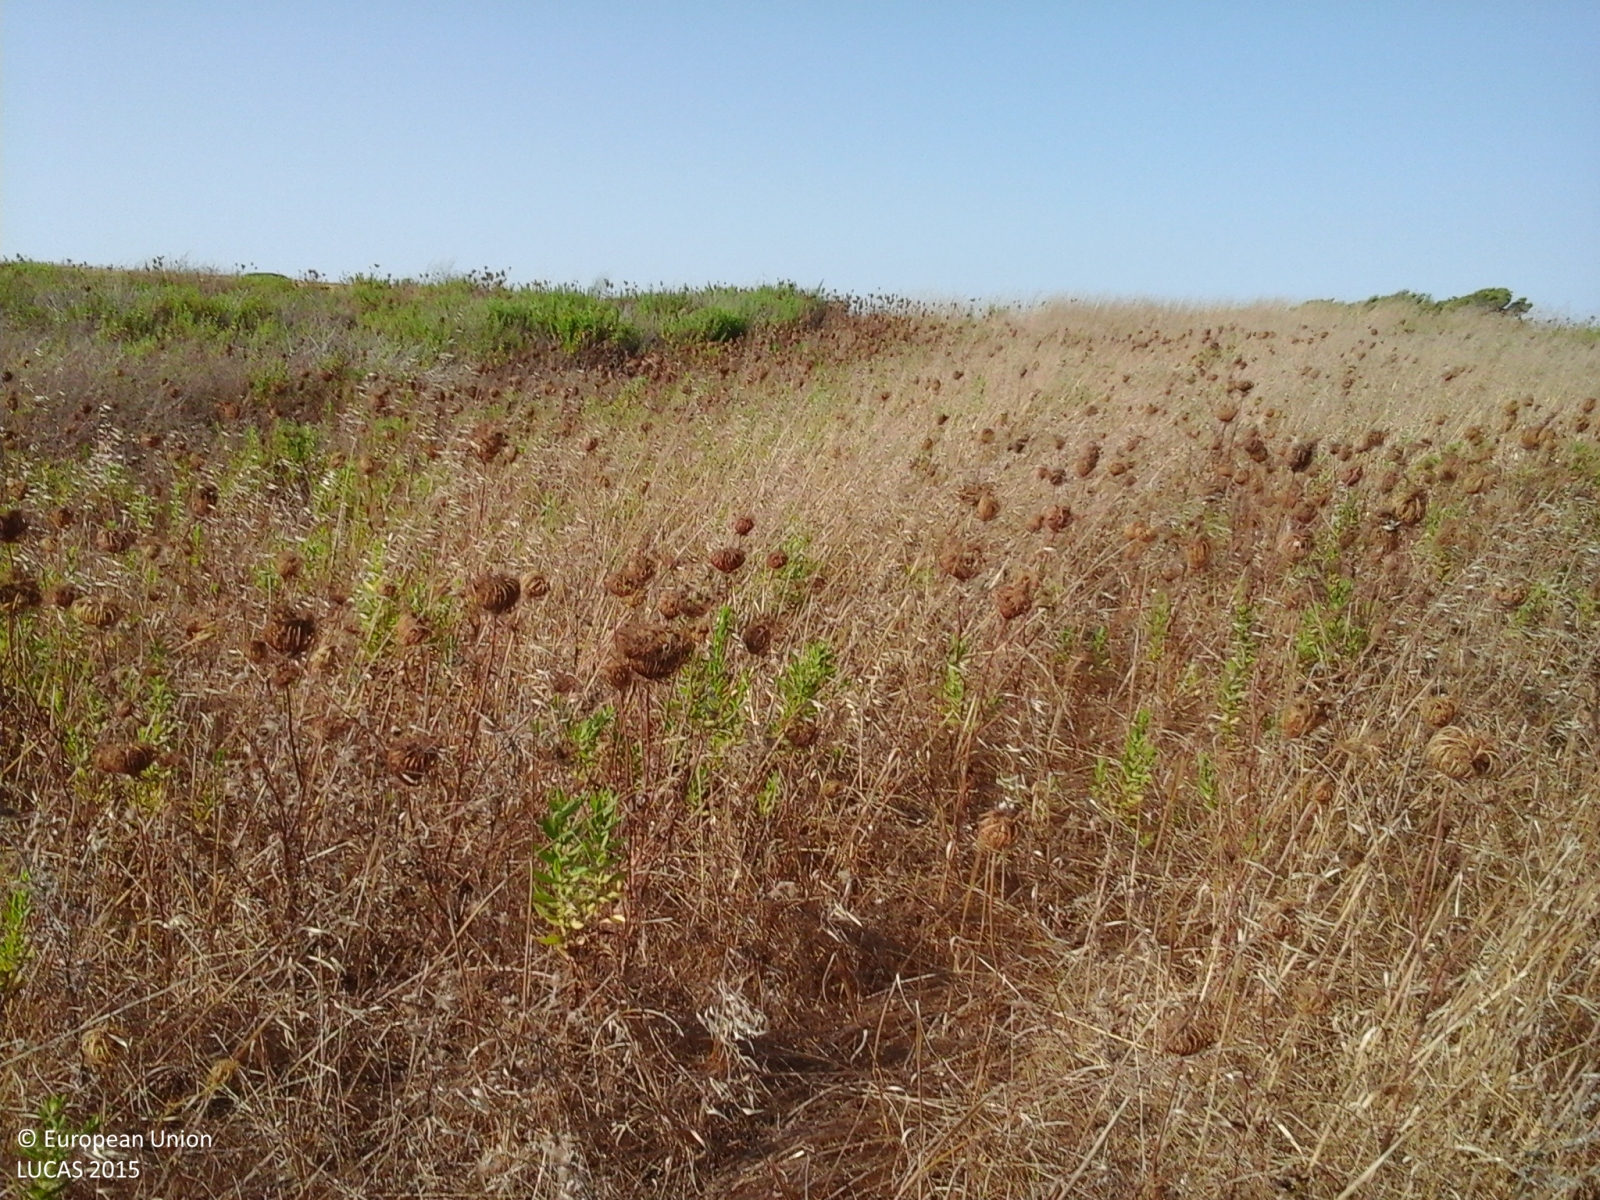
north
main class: Grassland
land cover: Spontaneously vegetated surfaces
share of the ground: > 75 %
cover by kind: herbaceous plants 100 %
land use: Fallow land
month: July
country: IT
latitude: 39.8926
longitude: 8.4299
